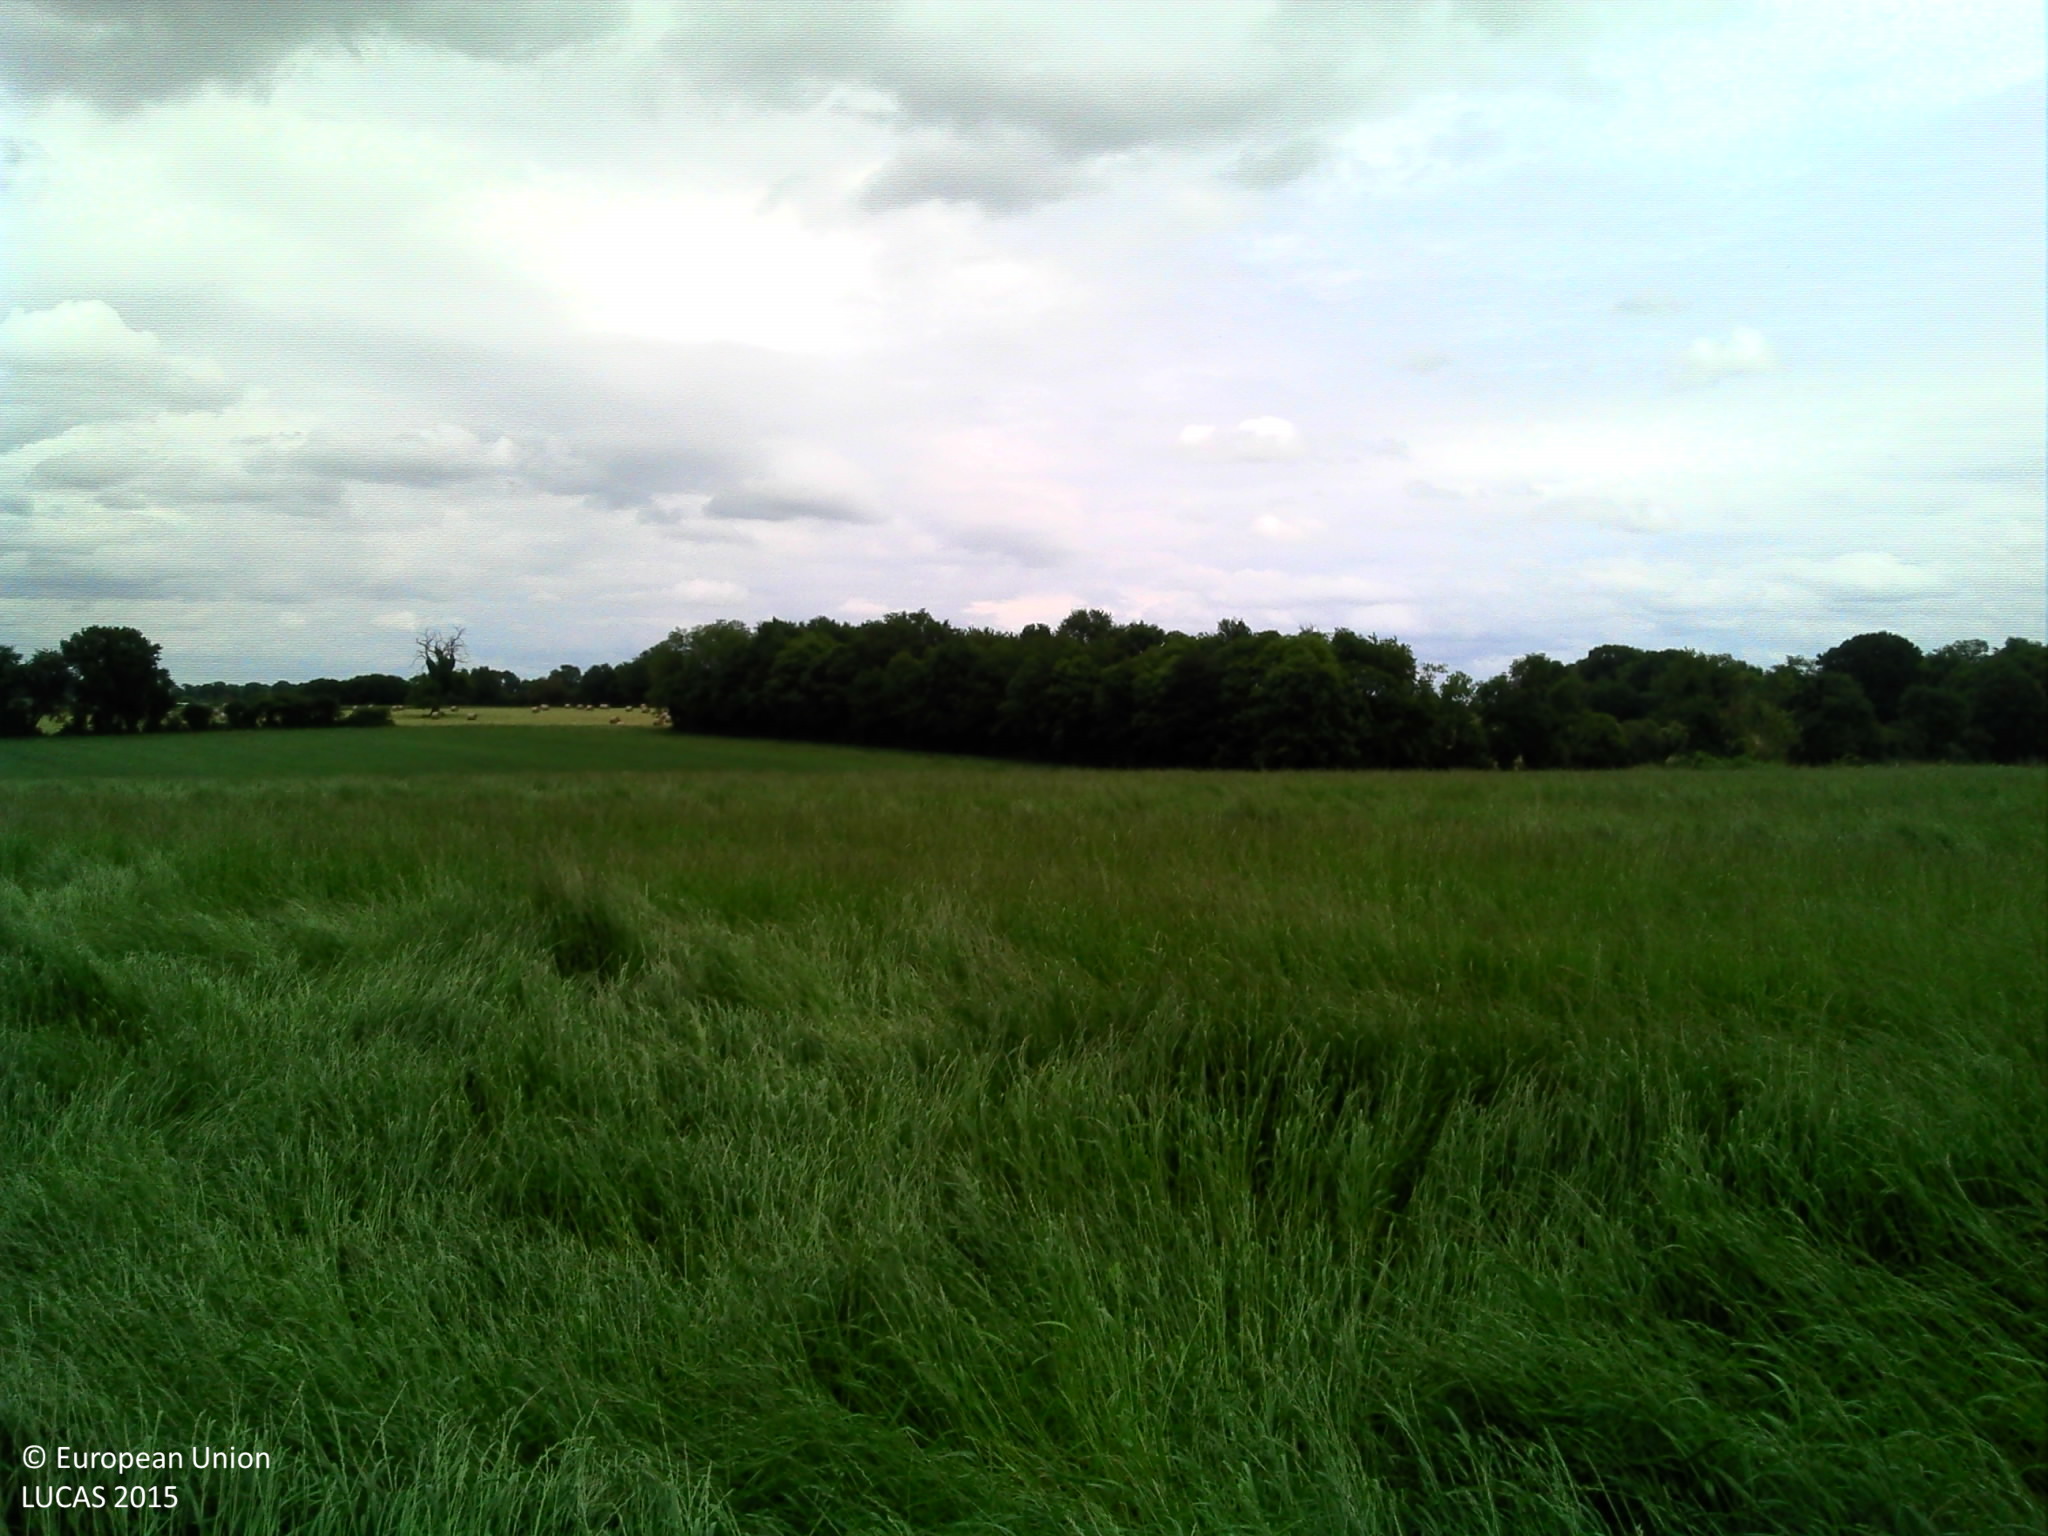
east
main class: Cropland
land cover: Temporary grasslands
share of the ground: > 75 %
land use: Agriculture (excluding fallow land and kitchen gardens)
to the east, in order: Temporary grasslands; Broadleaved woodland; Fences; Temporary grasslands
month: June
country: FR
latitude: 46.0415
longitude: 0.3564
